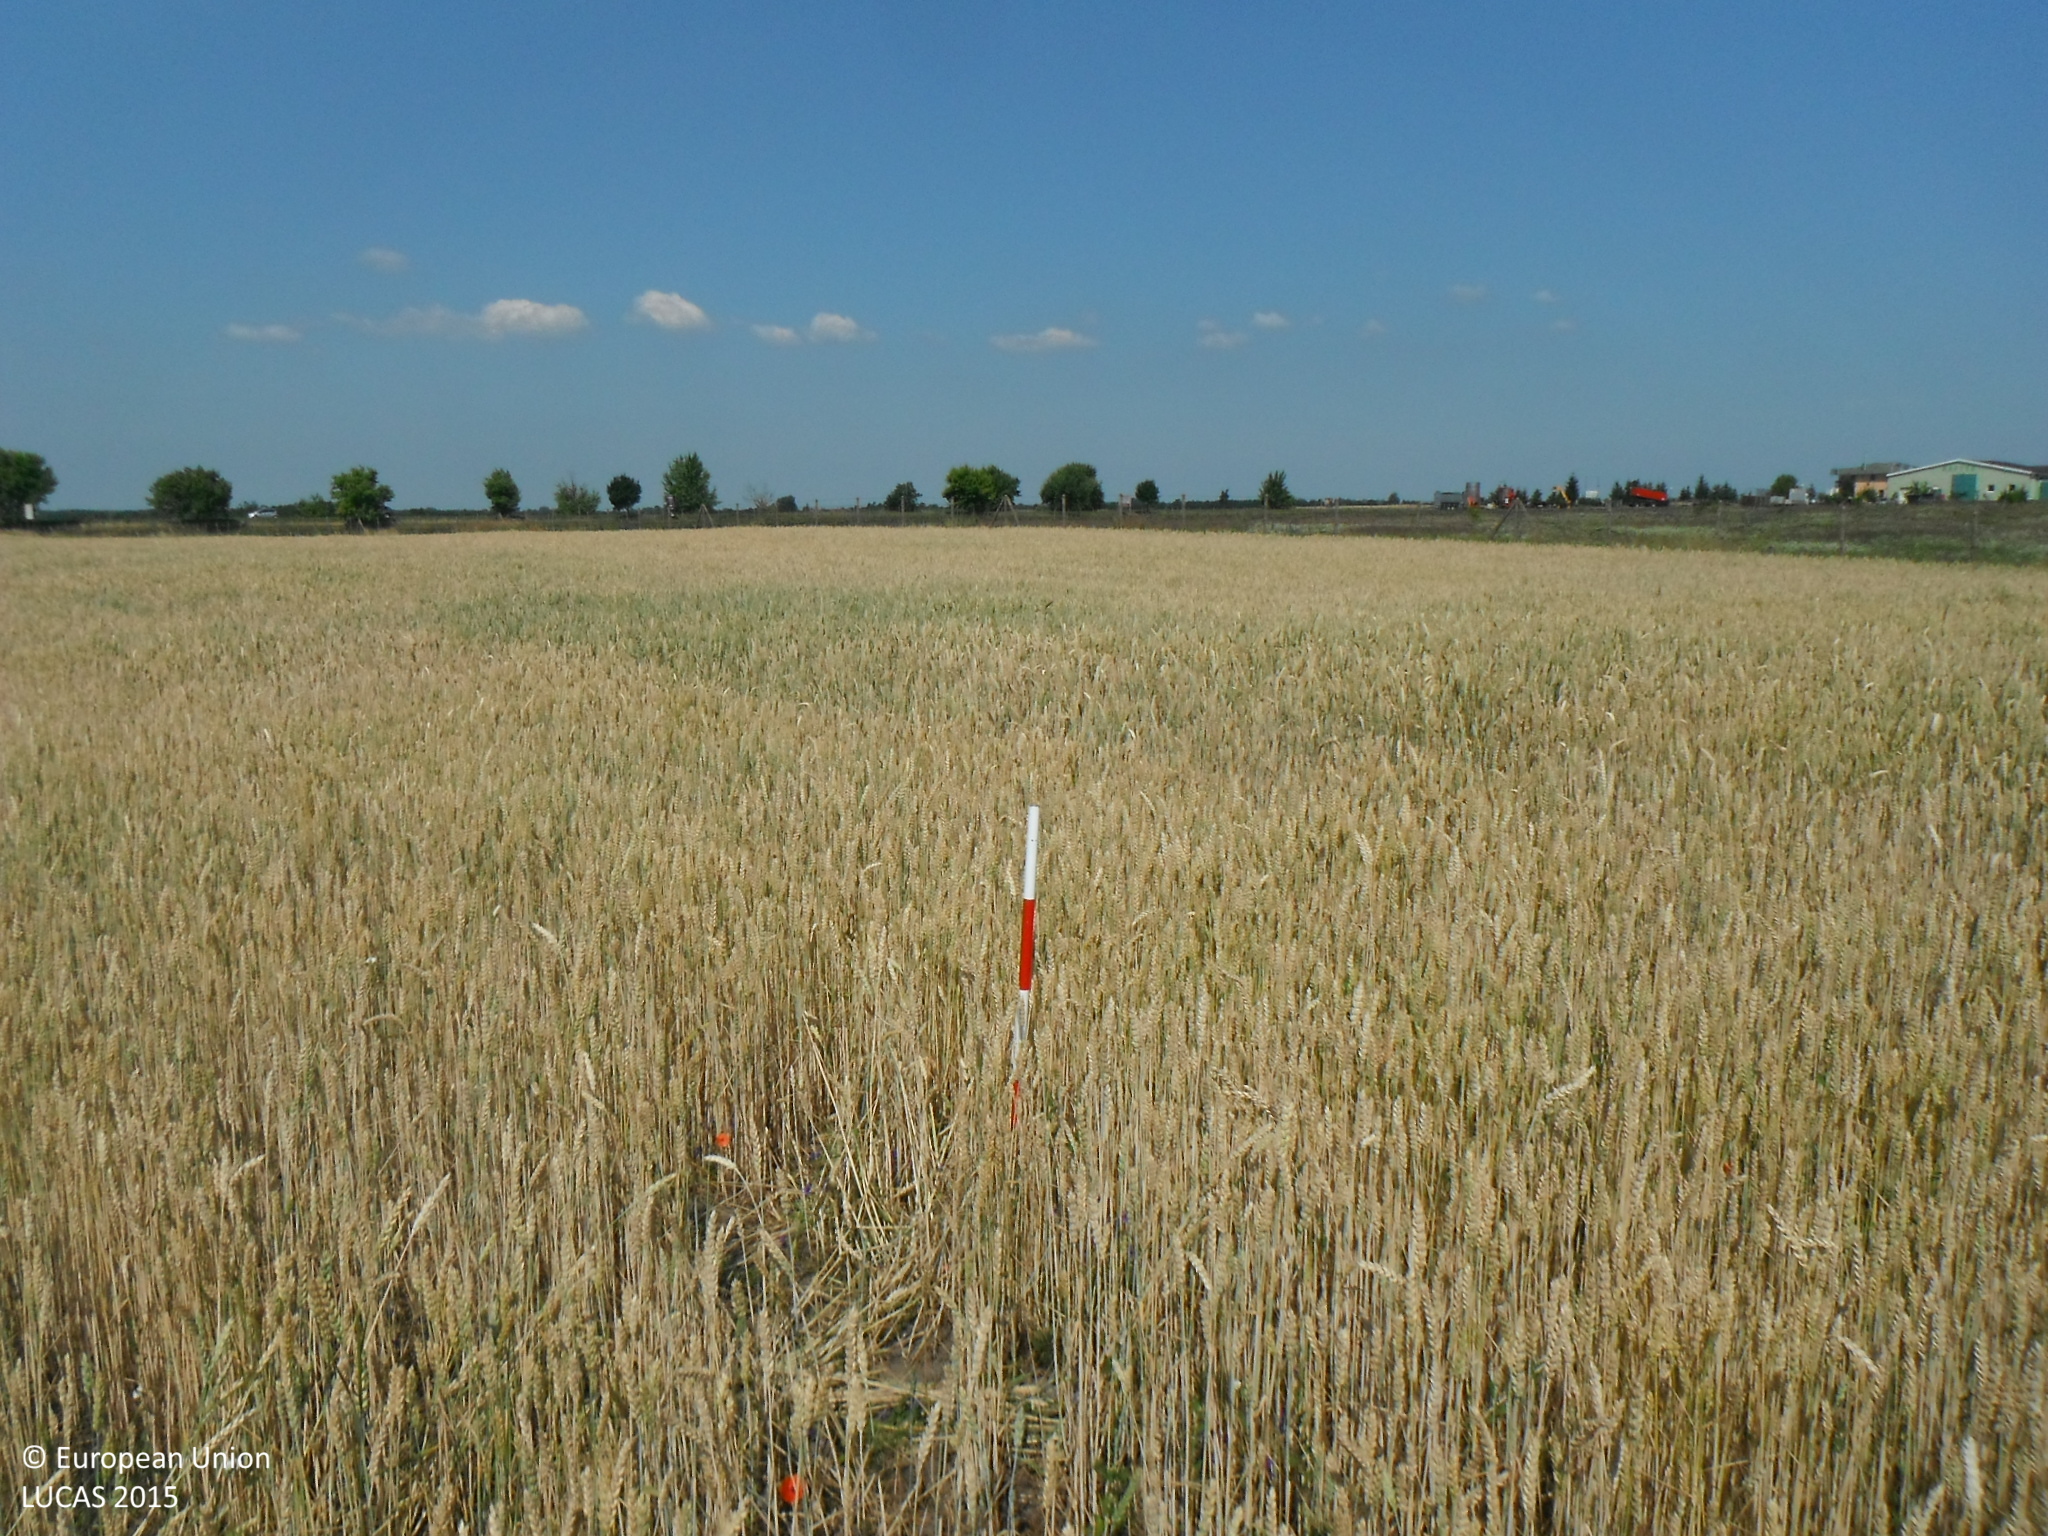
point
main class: Cropland
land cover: Common wheat
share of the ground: > 75 %
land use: Agriculture (excluding fallow land and kitchen gardens)
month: June
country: SK
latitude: 47.9543
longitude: 18.1951
